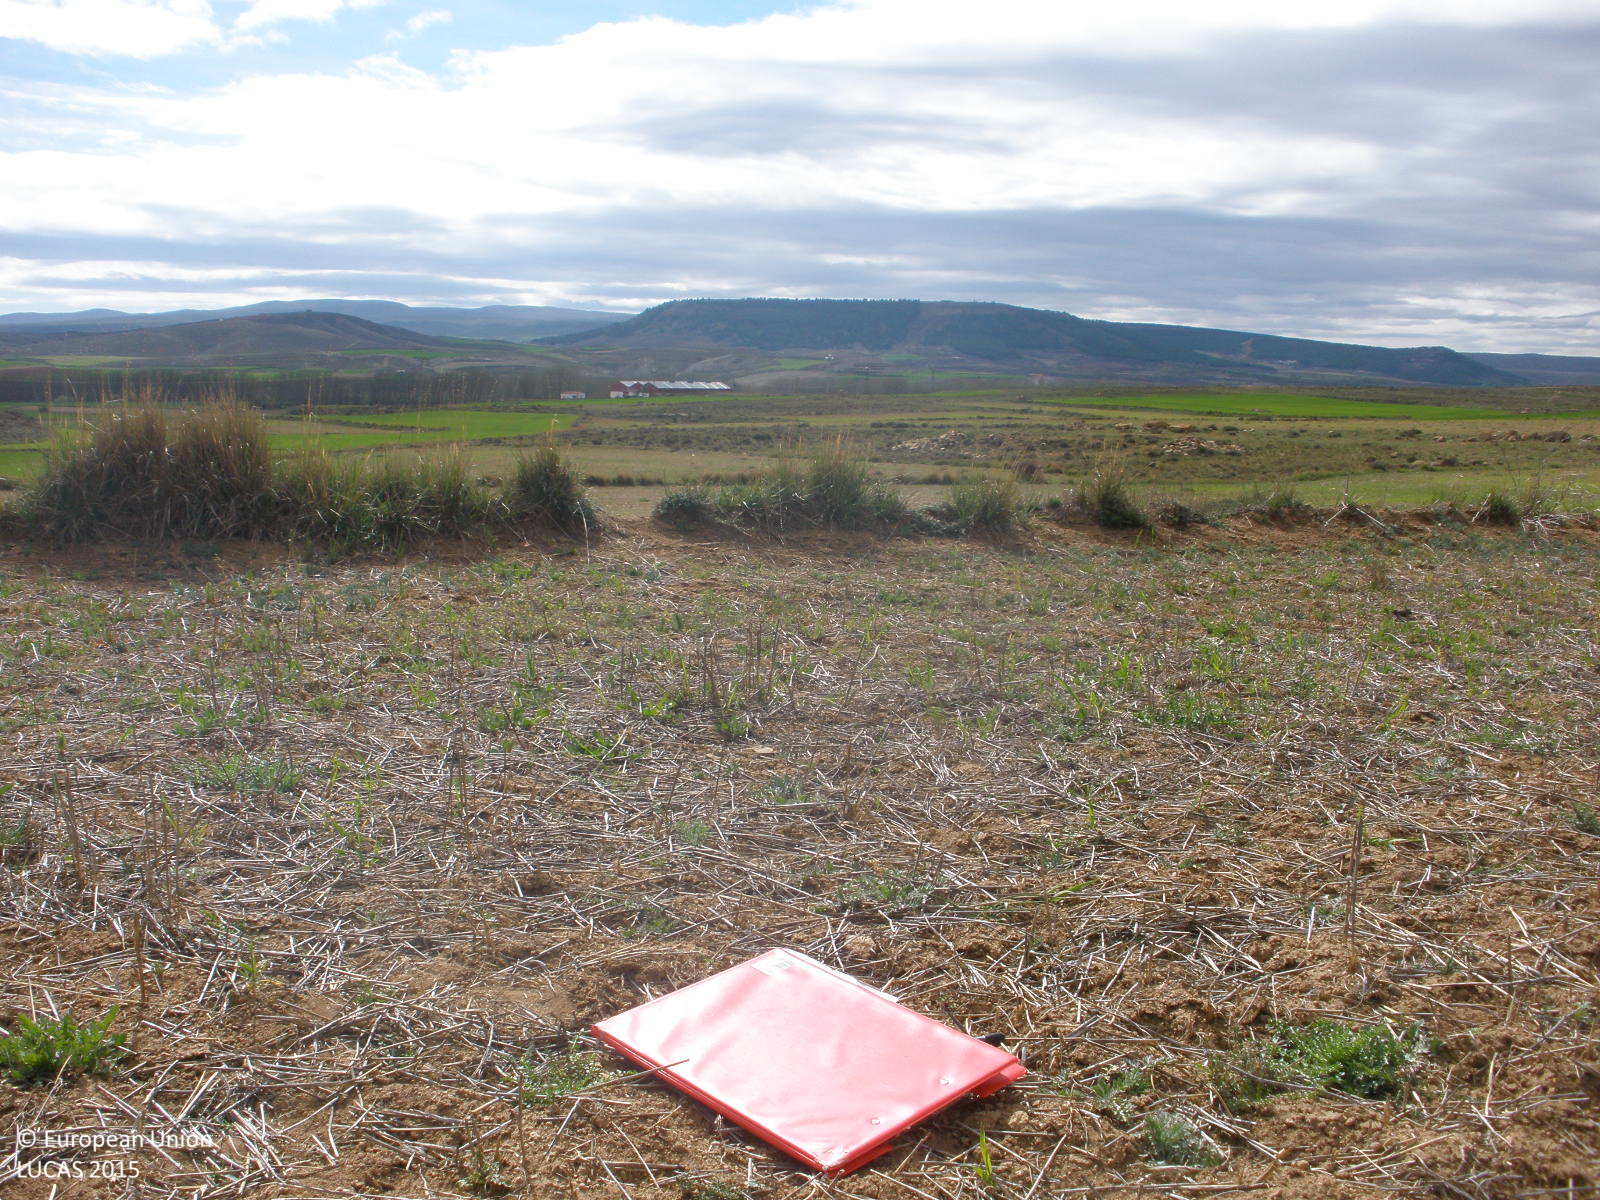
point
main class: Grassland
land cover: Spontaneously vegetated surfaces
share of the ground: 25 - 50 %
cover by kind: unconsolidated bare surface 60 %, herbaceous plants 40 %
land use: Agriculture (excluding fallow land and kitchen gardens)
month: May
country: ES
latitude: 40.5661
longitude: -0.7708
